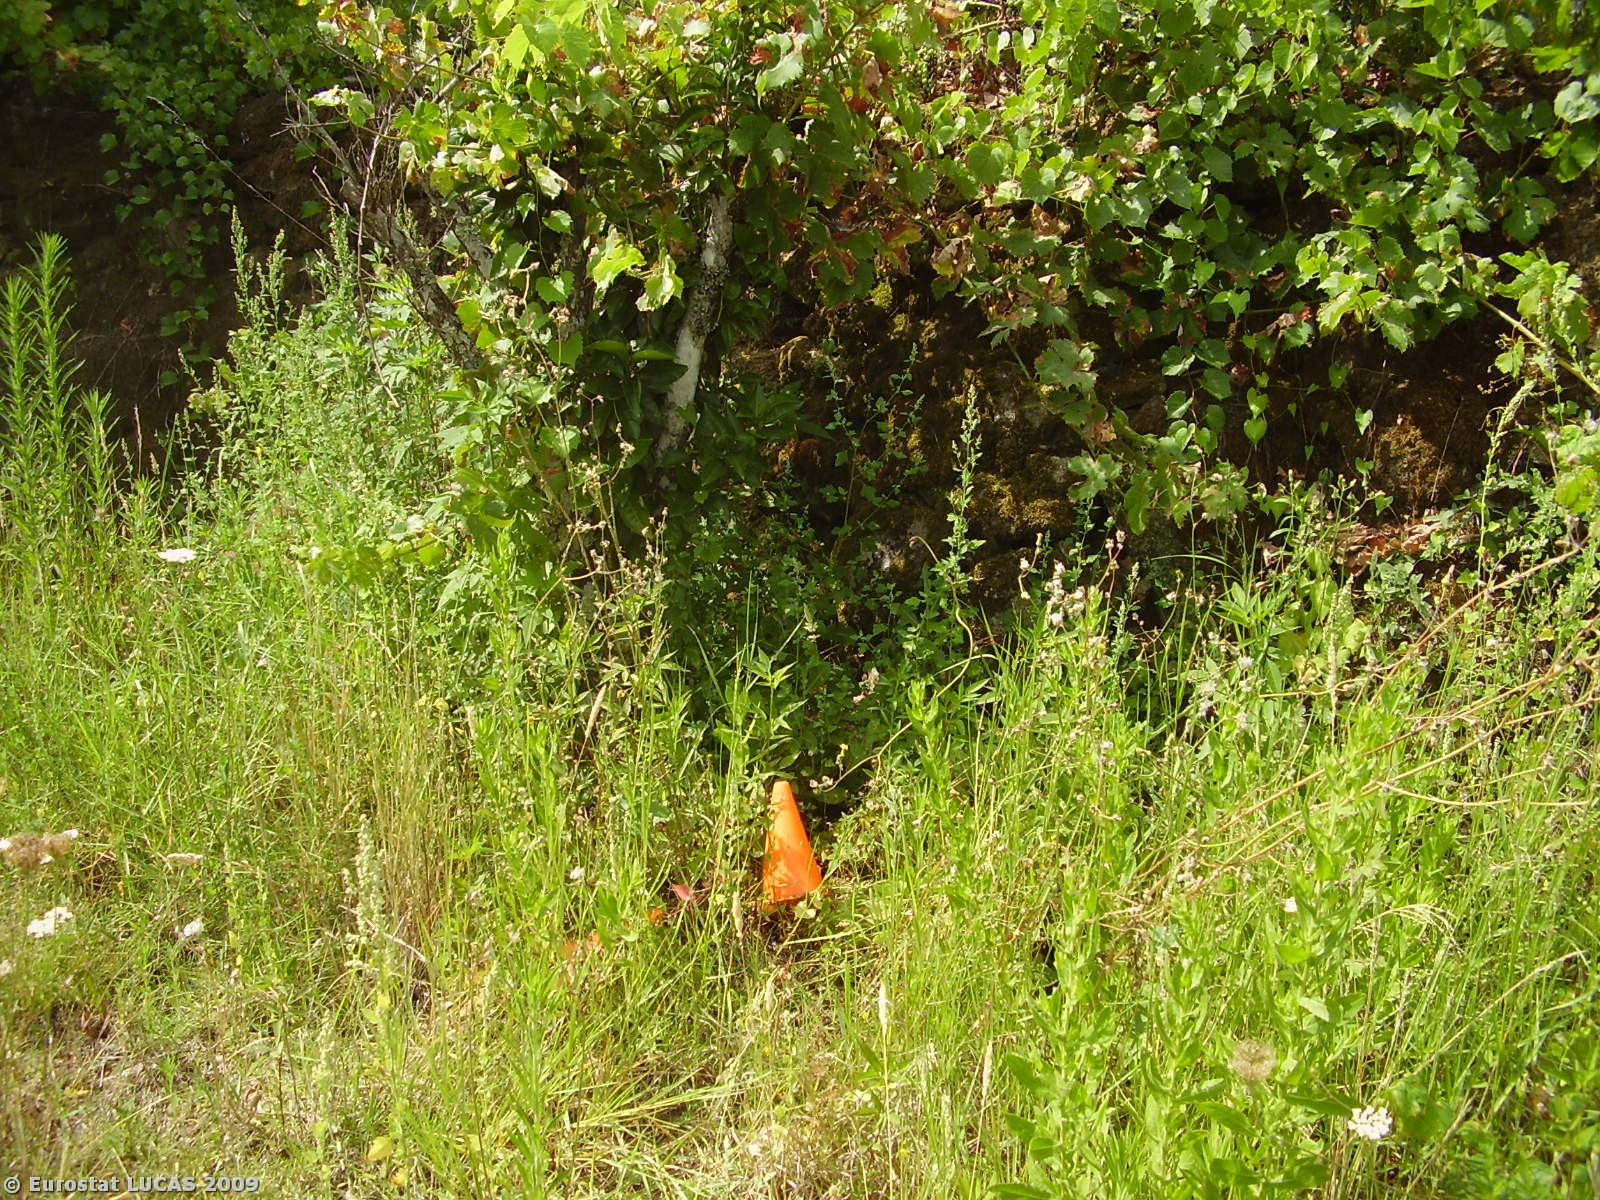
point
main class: Cropland
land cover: Olive groves
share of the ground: 25 - 50 %
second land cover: Spontaneously vegetated surfaces
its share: 50 - 75 %
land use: Agriculture (excluding fallow land and kitchen gardens)
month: July
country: PT
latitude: 39.5233
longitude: -8.0332
